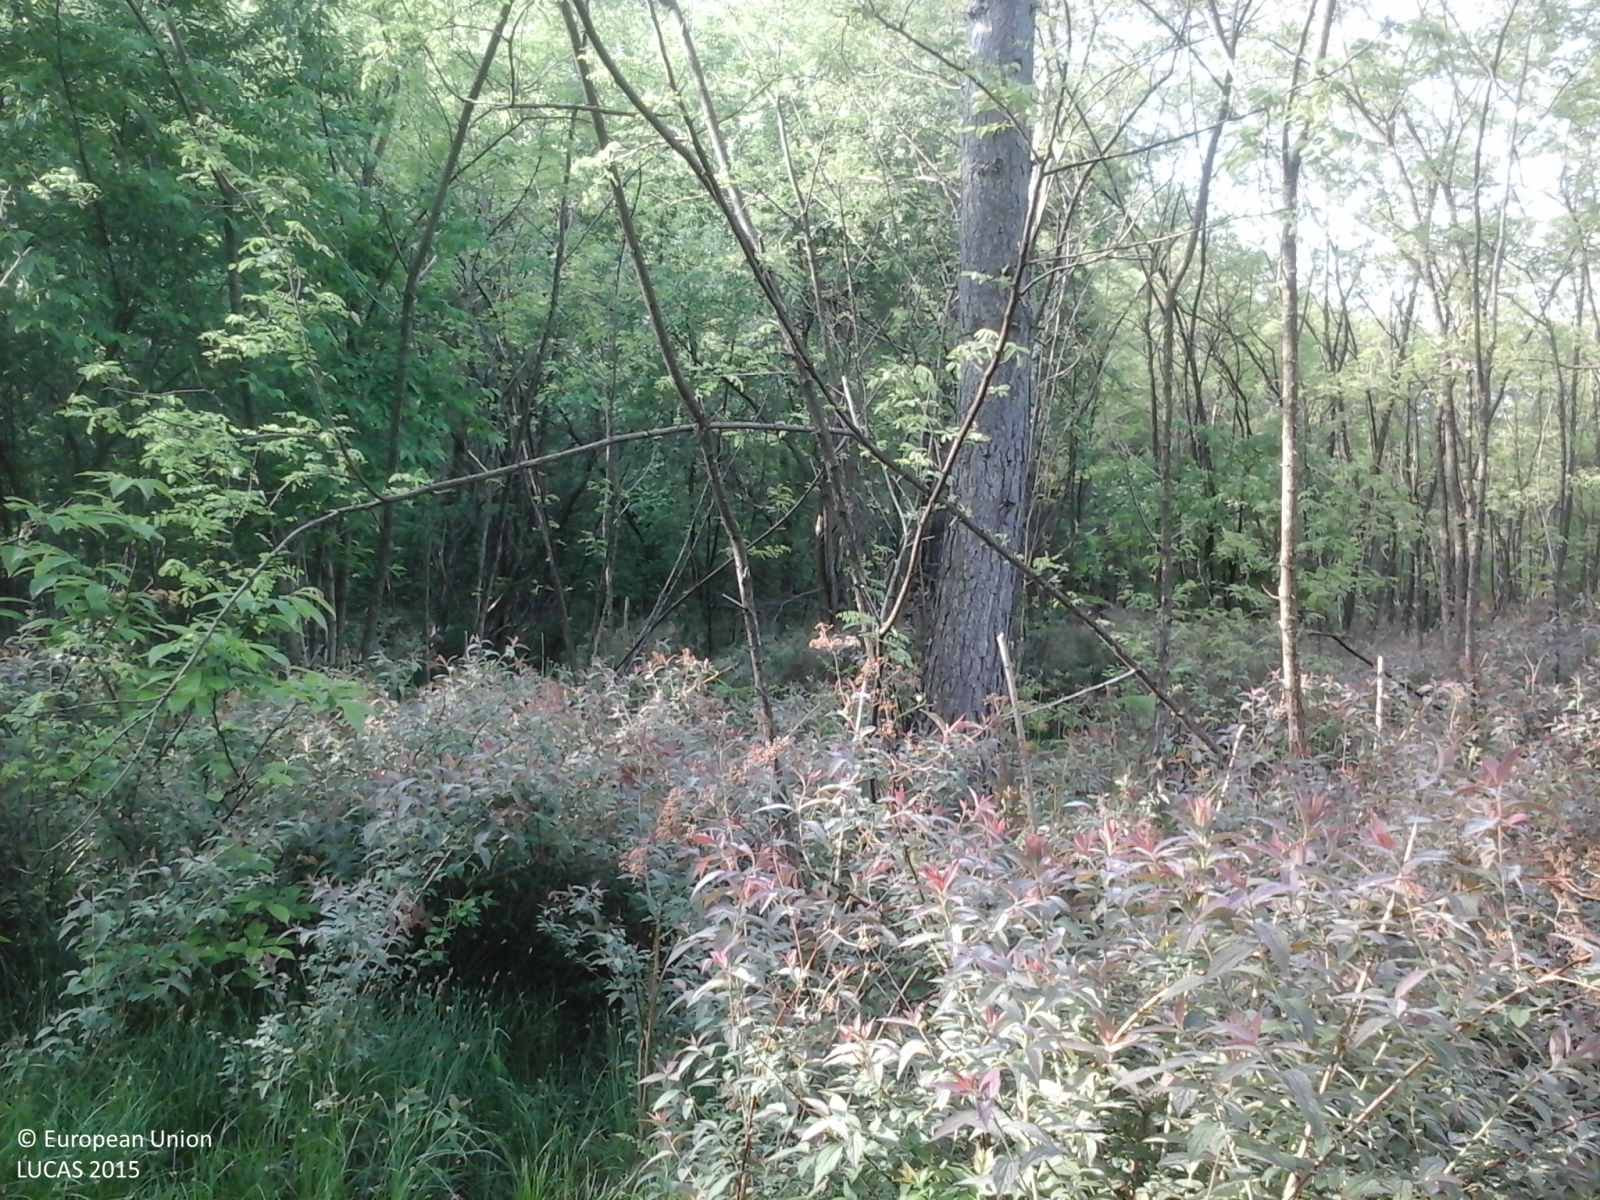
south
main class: Grassland
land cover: Grassland without tree/shrub cover
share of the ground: > 75 %
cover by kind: herbaceous plants 100 %
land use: Agriculture (excluding fallow land and kitchen gardens)
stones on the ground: < 10 %
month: May
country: IT
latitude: 45.7994
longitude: 8.4456
